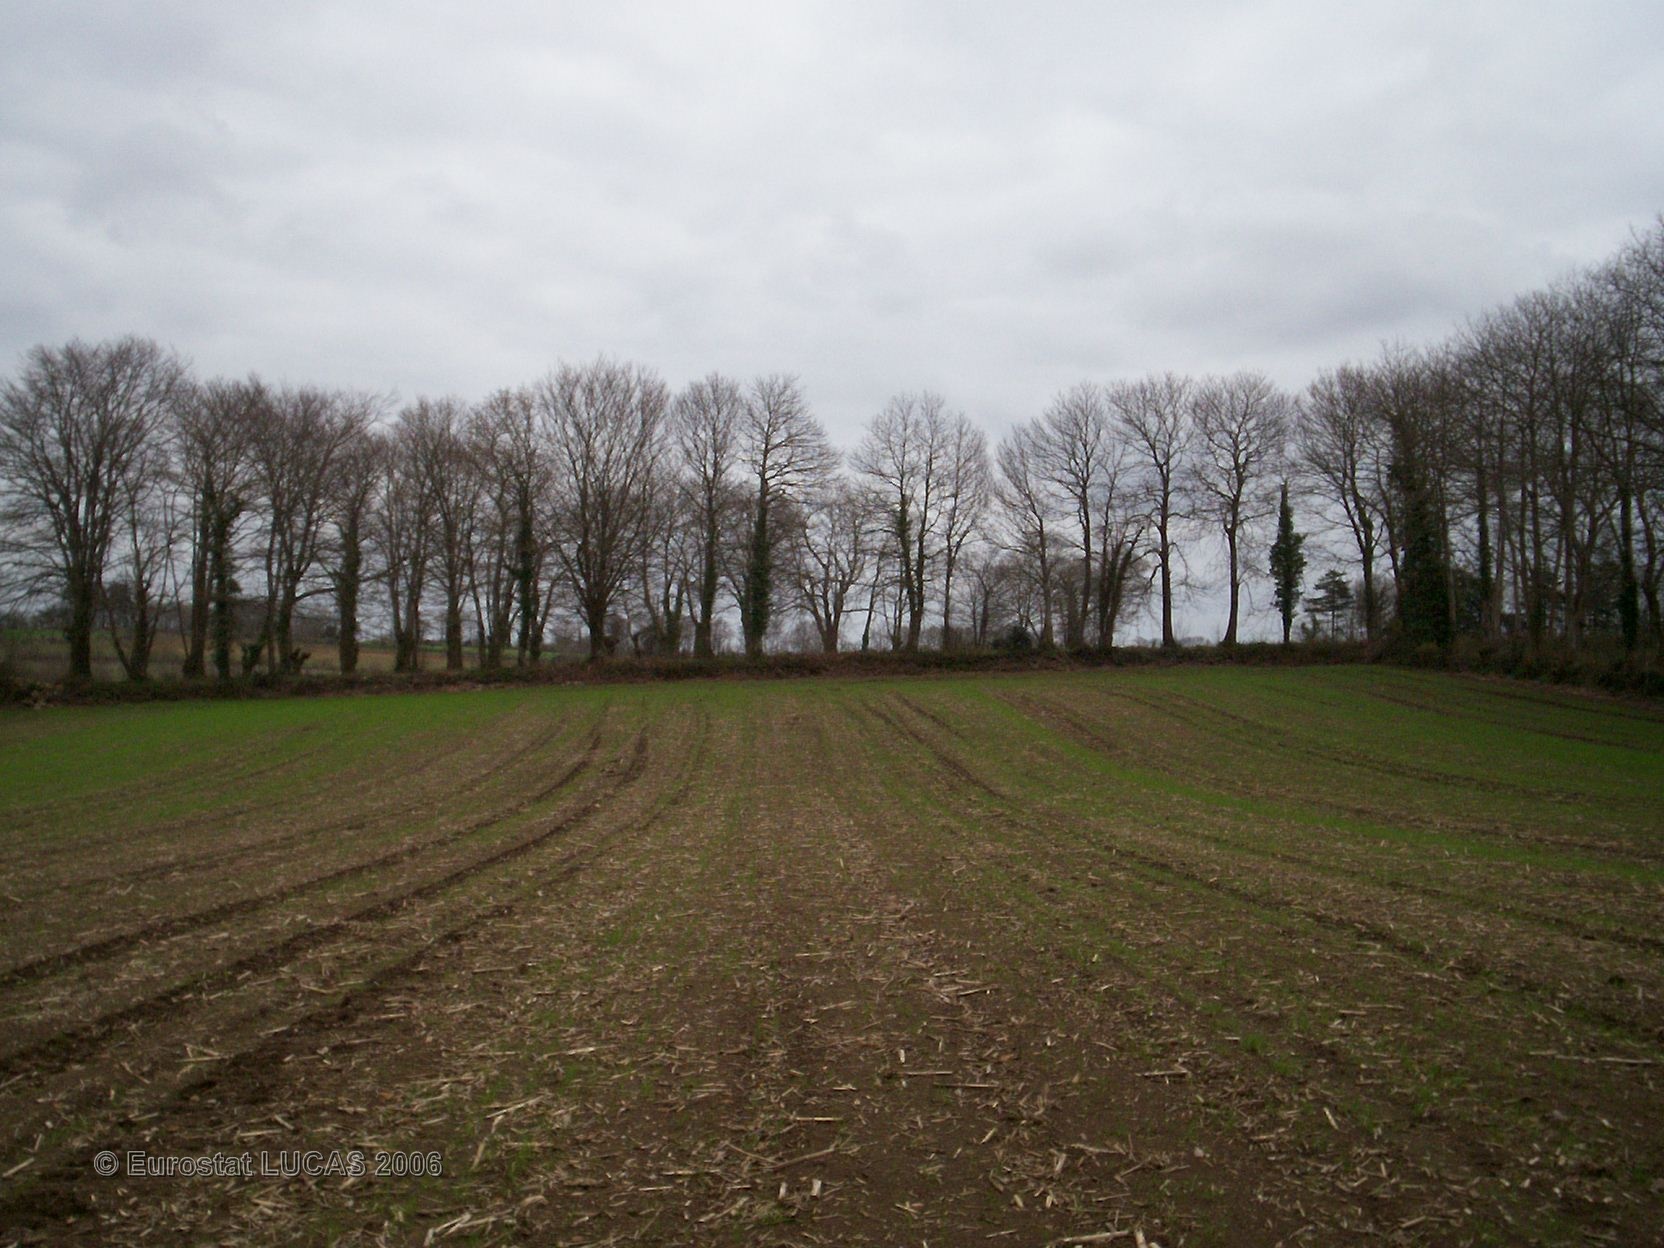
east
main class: Grassland
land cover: Grassland without tree/shrub cover
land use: Agriculture (excluding fallow land and kitchen gardens)
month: April
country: FR
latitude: 47.9674
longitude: -3.5383
